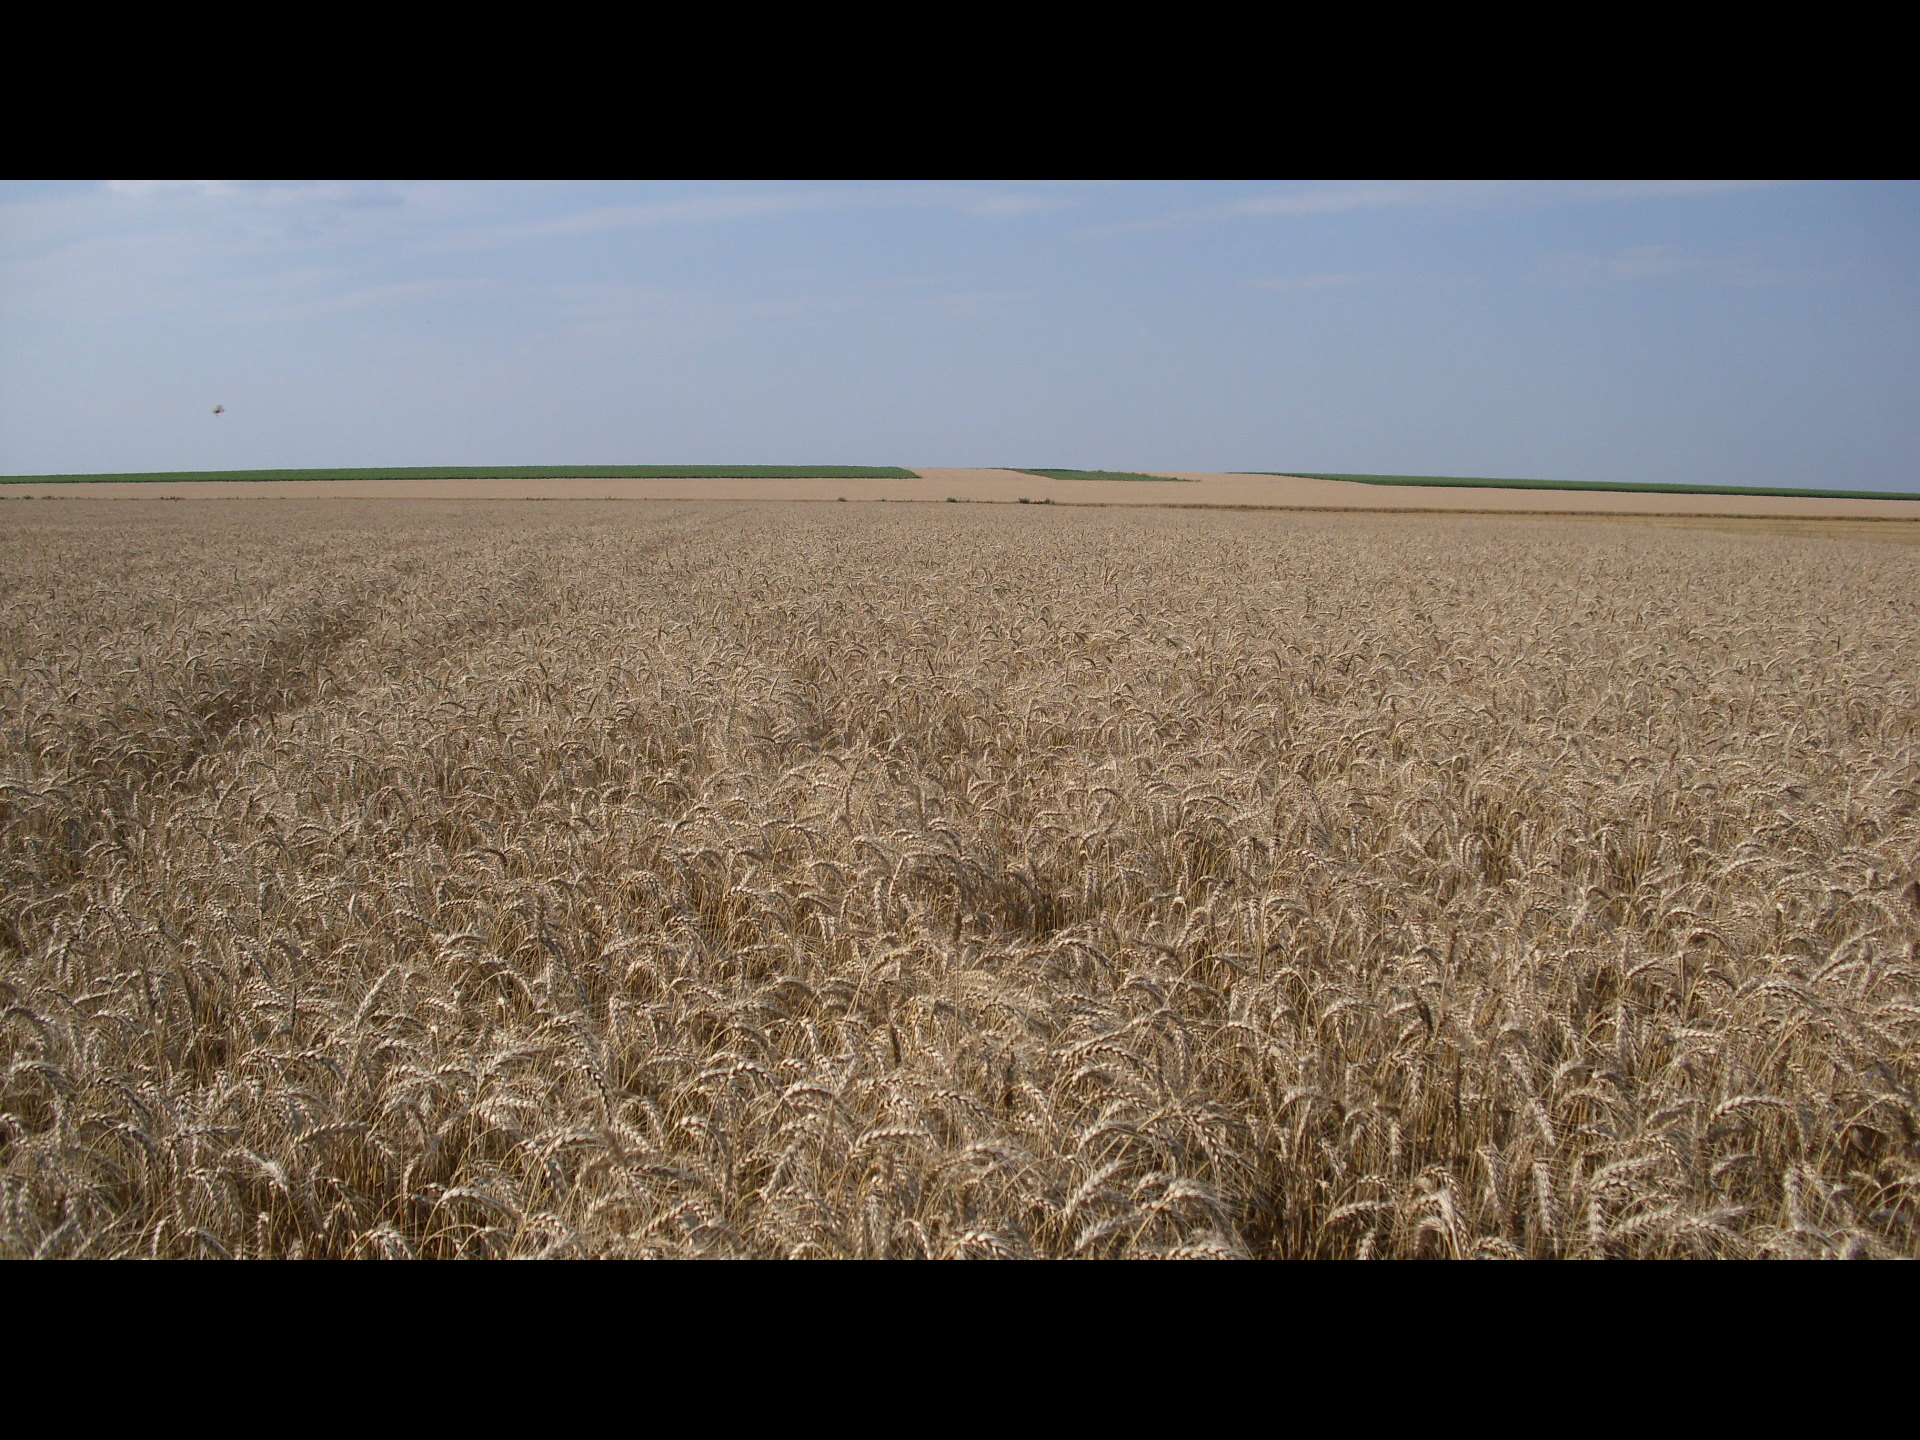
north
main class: Cropland
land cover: Common wheat
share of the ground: > 75 %
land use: Agriculture (excluding fallow land and kitchen gardens)
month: June
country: BG
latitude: 43.6661
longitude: 23.3507
